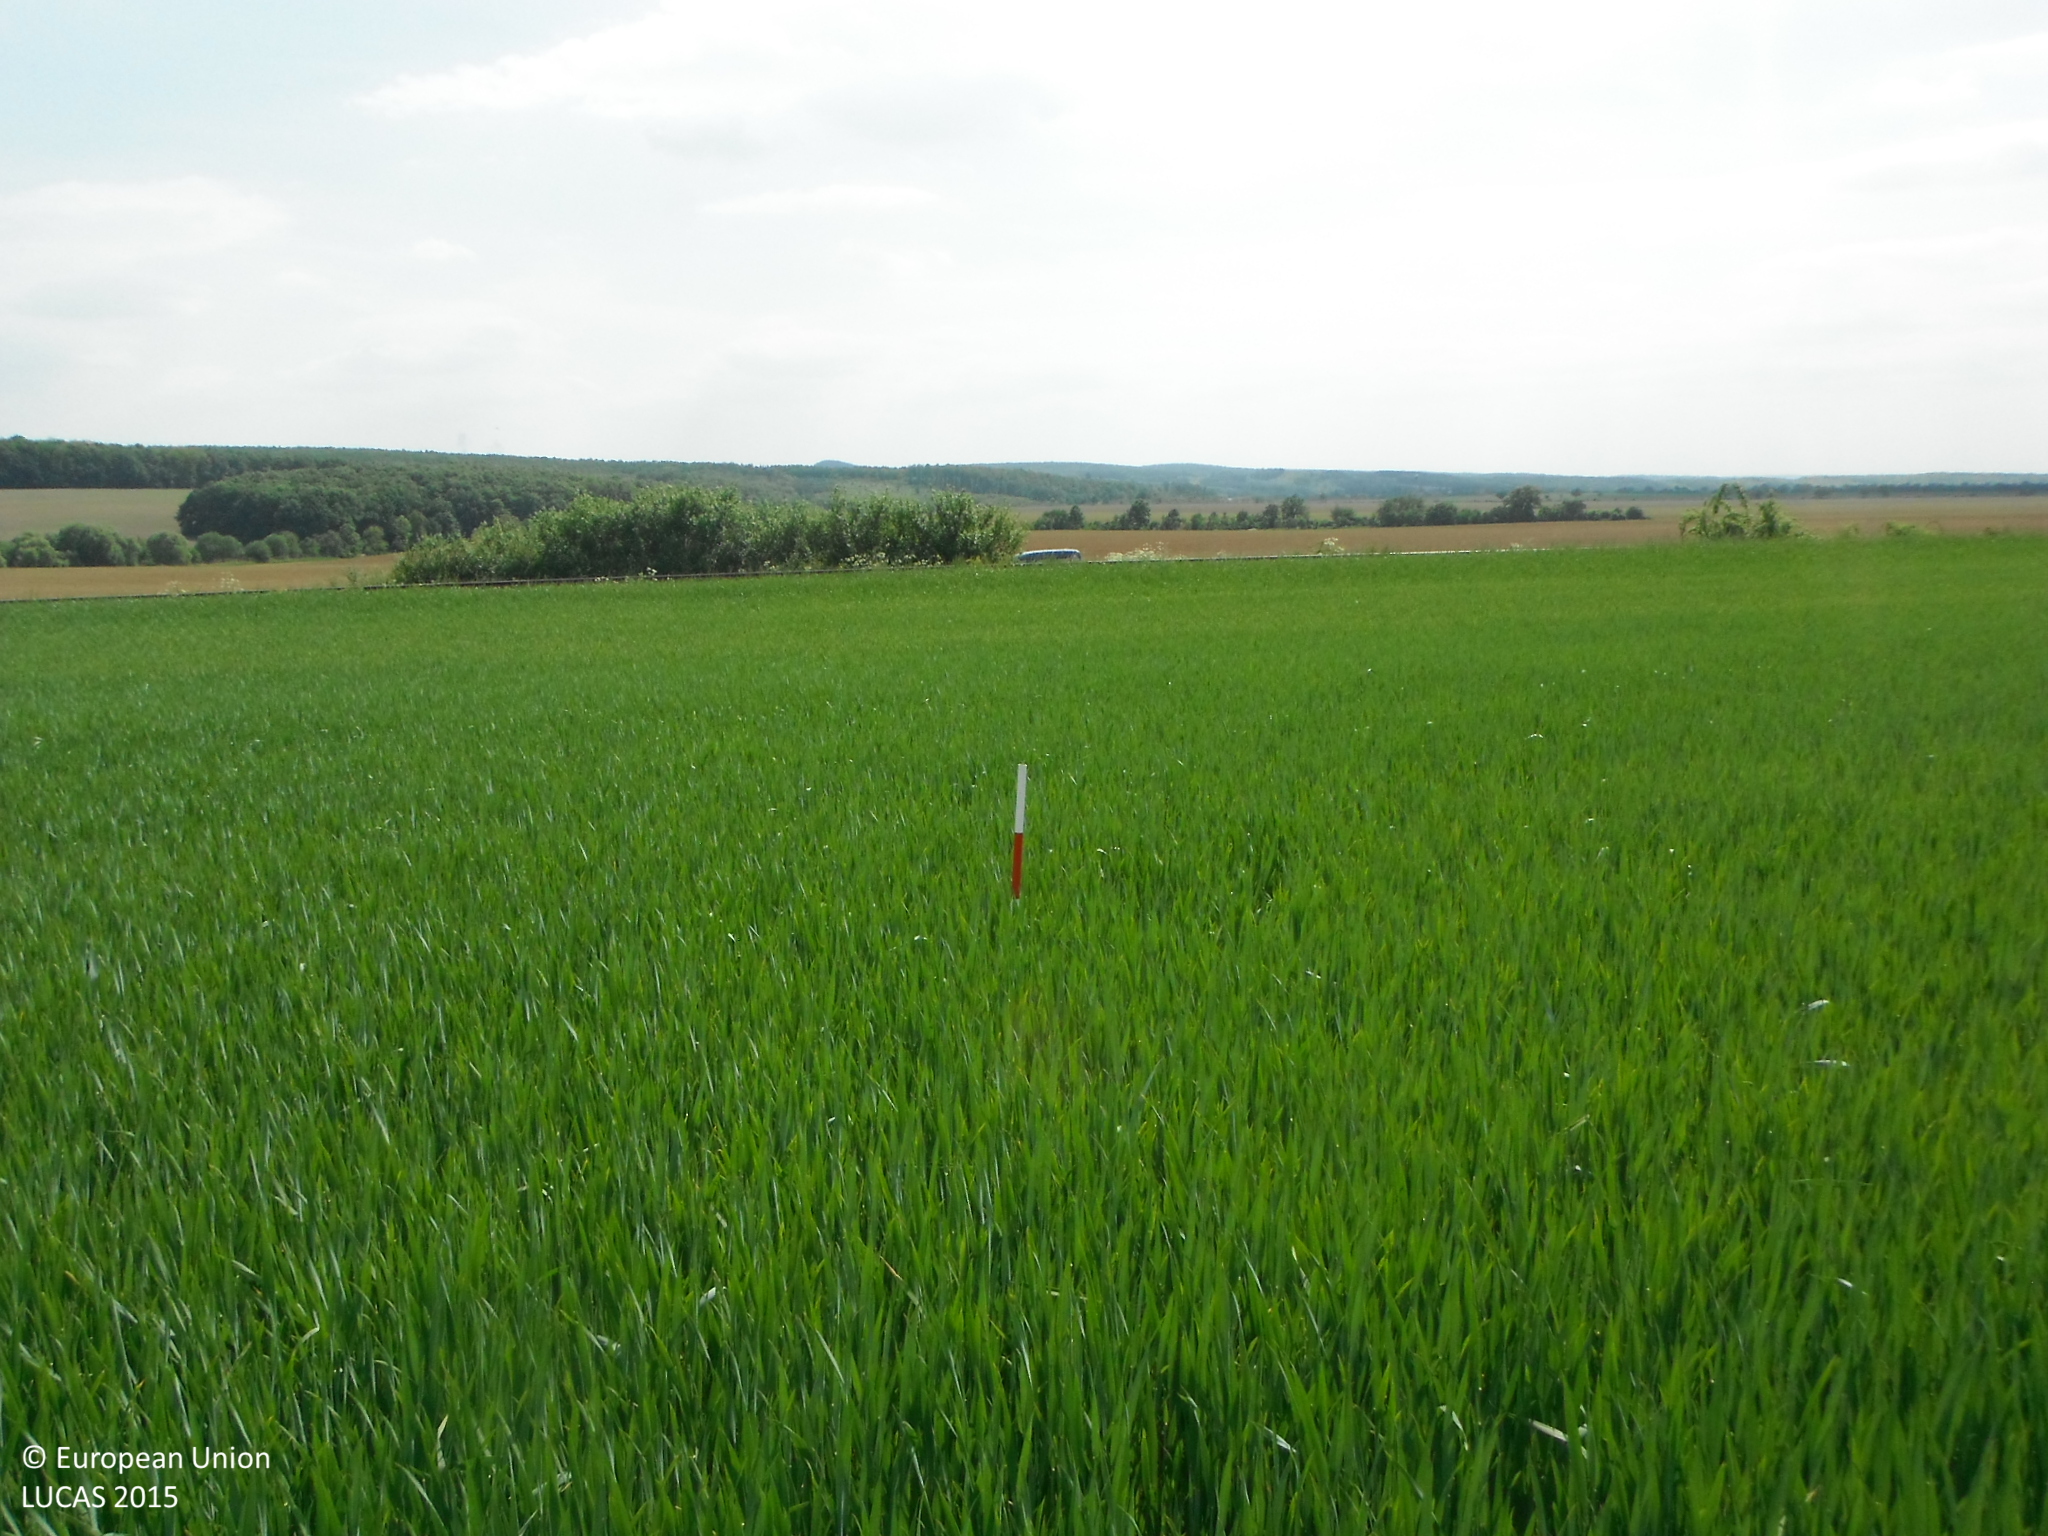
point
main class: Cropland
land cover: Common wheat
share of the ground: > 75 %
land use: Agriculture (excluding fallow land and kitchen gardens)
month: May
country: SK
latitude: 48.3310
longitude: 18.4738
